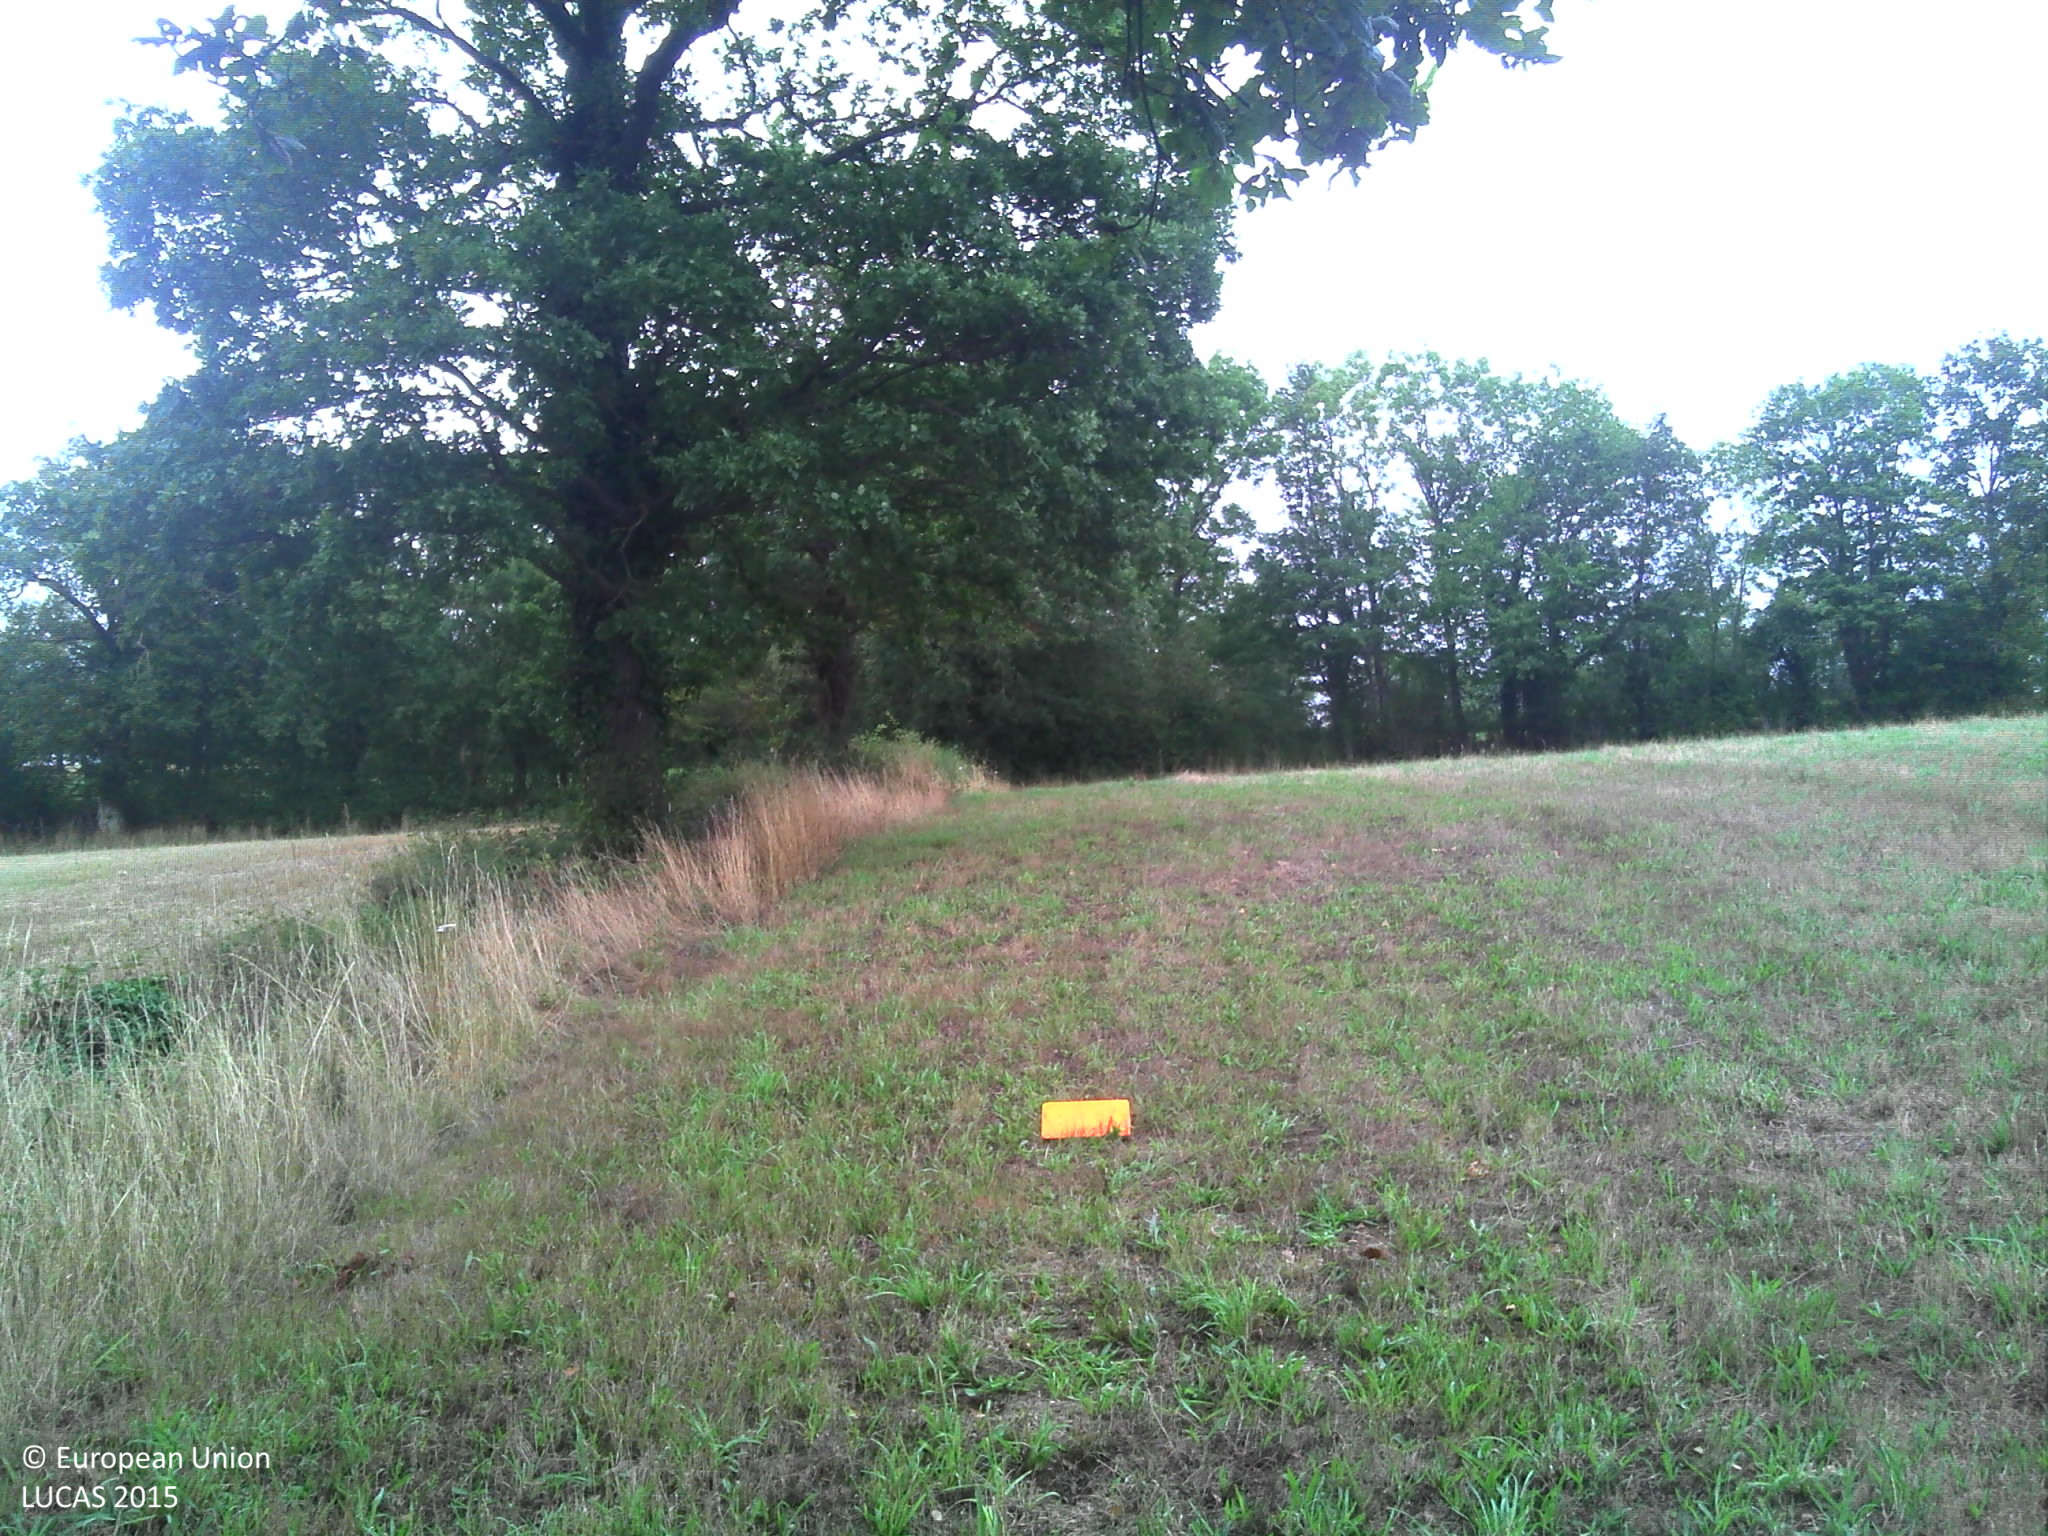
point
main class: Grassland
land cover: Grassland without tree/shrub cover
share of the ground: > 75 %
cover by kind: herbaceous plants 100 %
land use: Agriculture (excluding fallow land and kitchen gardens)
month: August
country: FR
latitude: 46.1075
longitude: 2.2716
